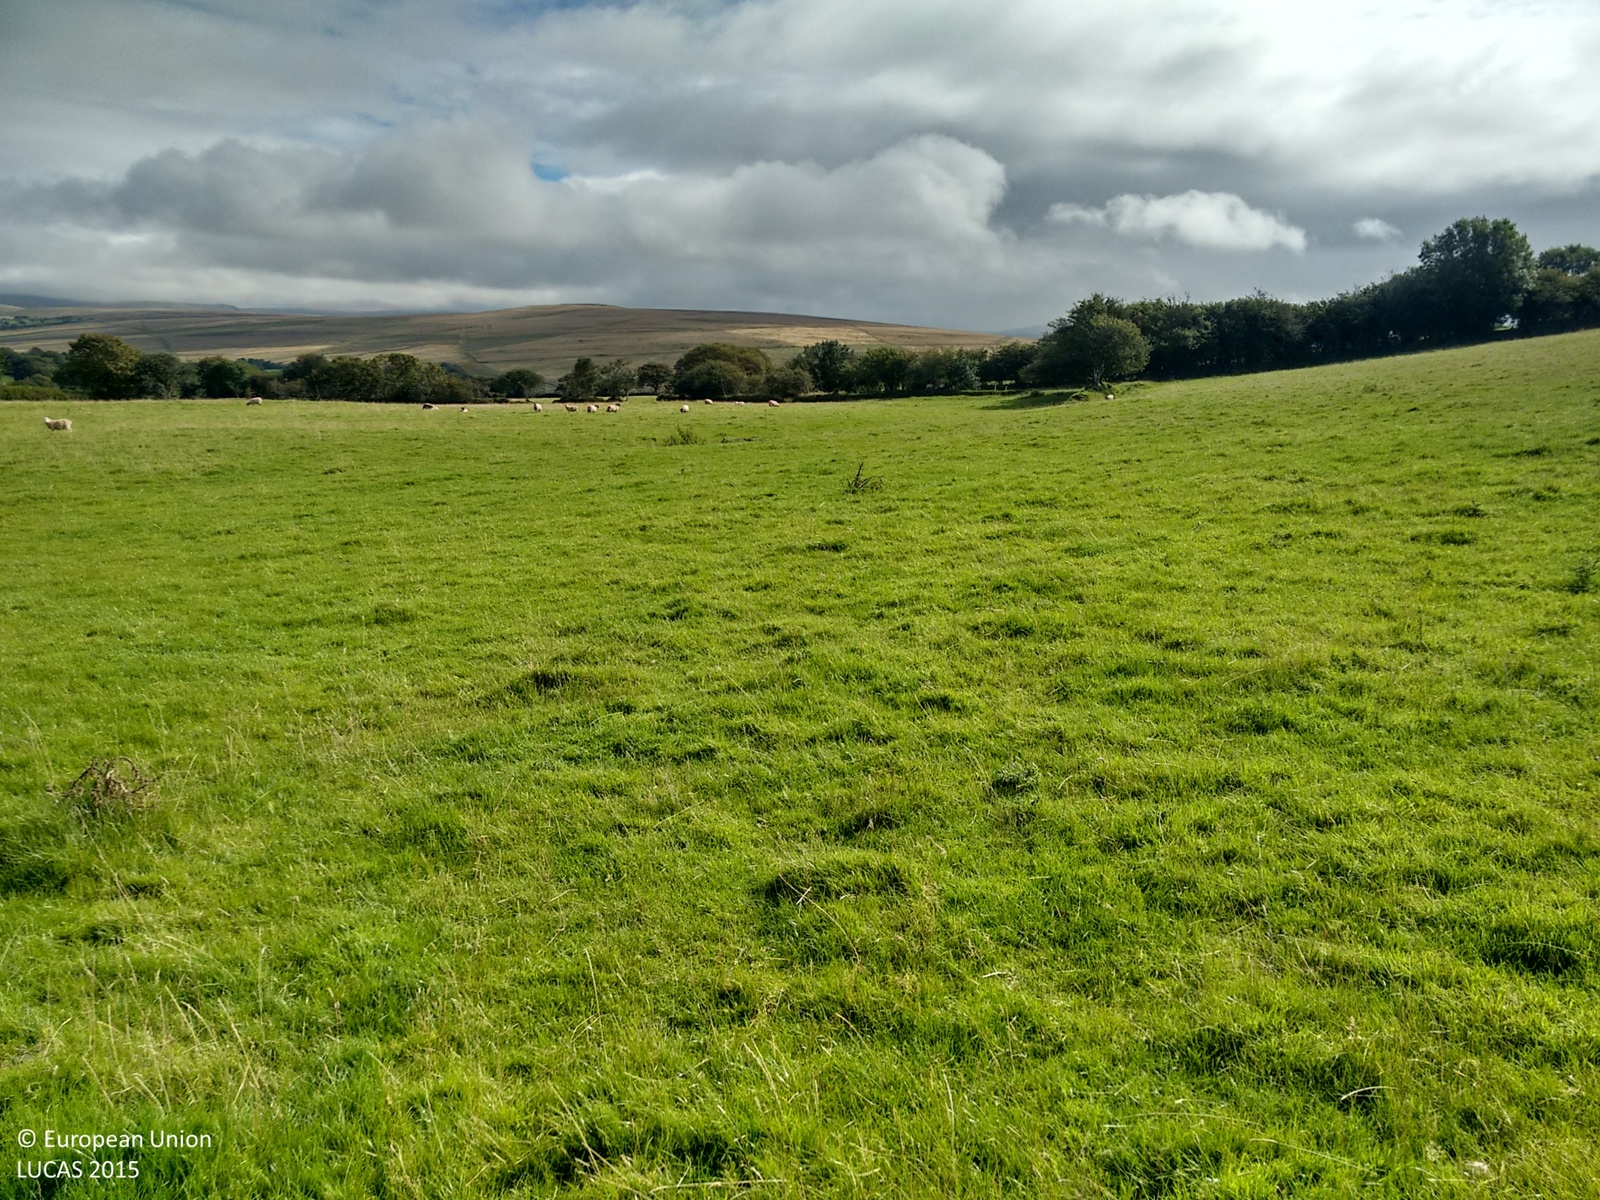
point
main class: Grassland
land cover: Grassland without tree/shrub cover
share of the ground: > 75 %
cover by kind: herbaceous plants 100 %
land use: Agriculture (excluding fallow land and kitchen gardens)
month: September
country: GB
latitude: 50.6099
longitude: -4.1577
